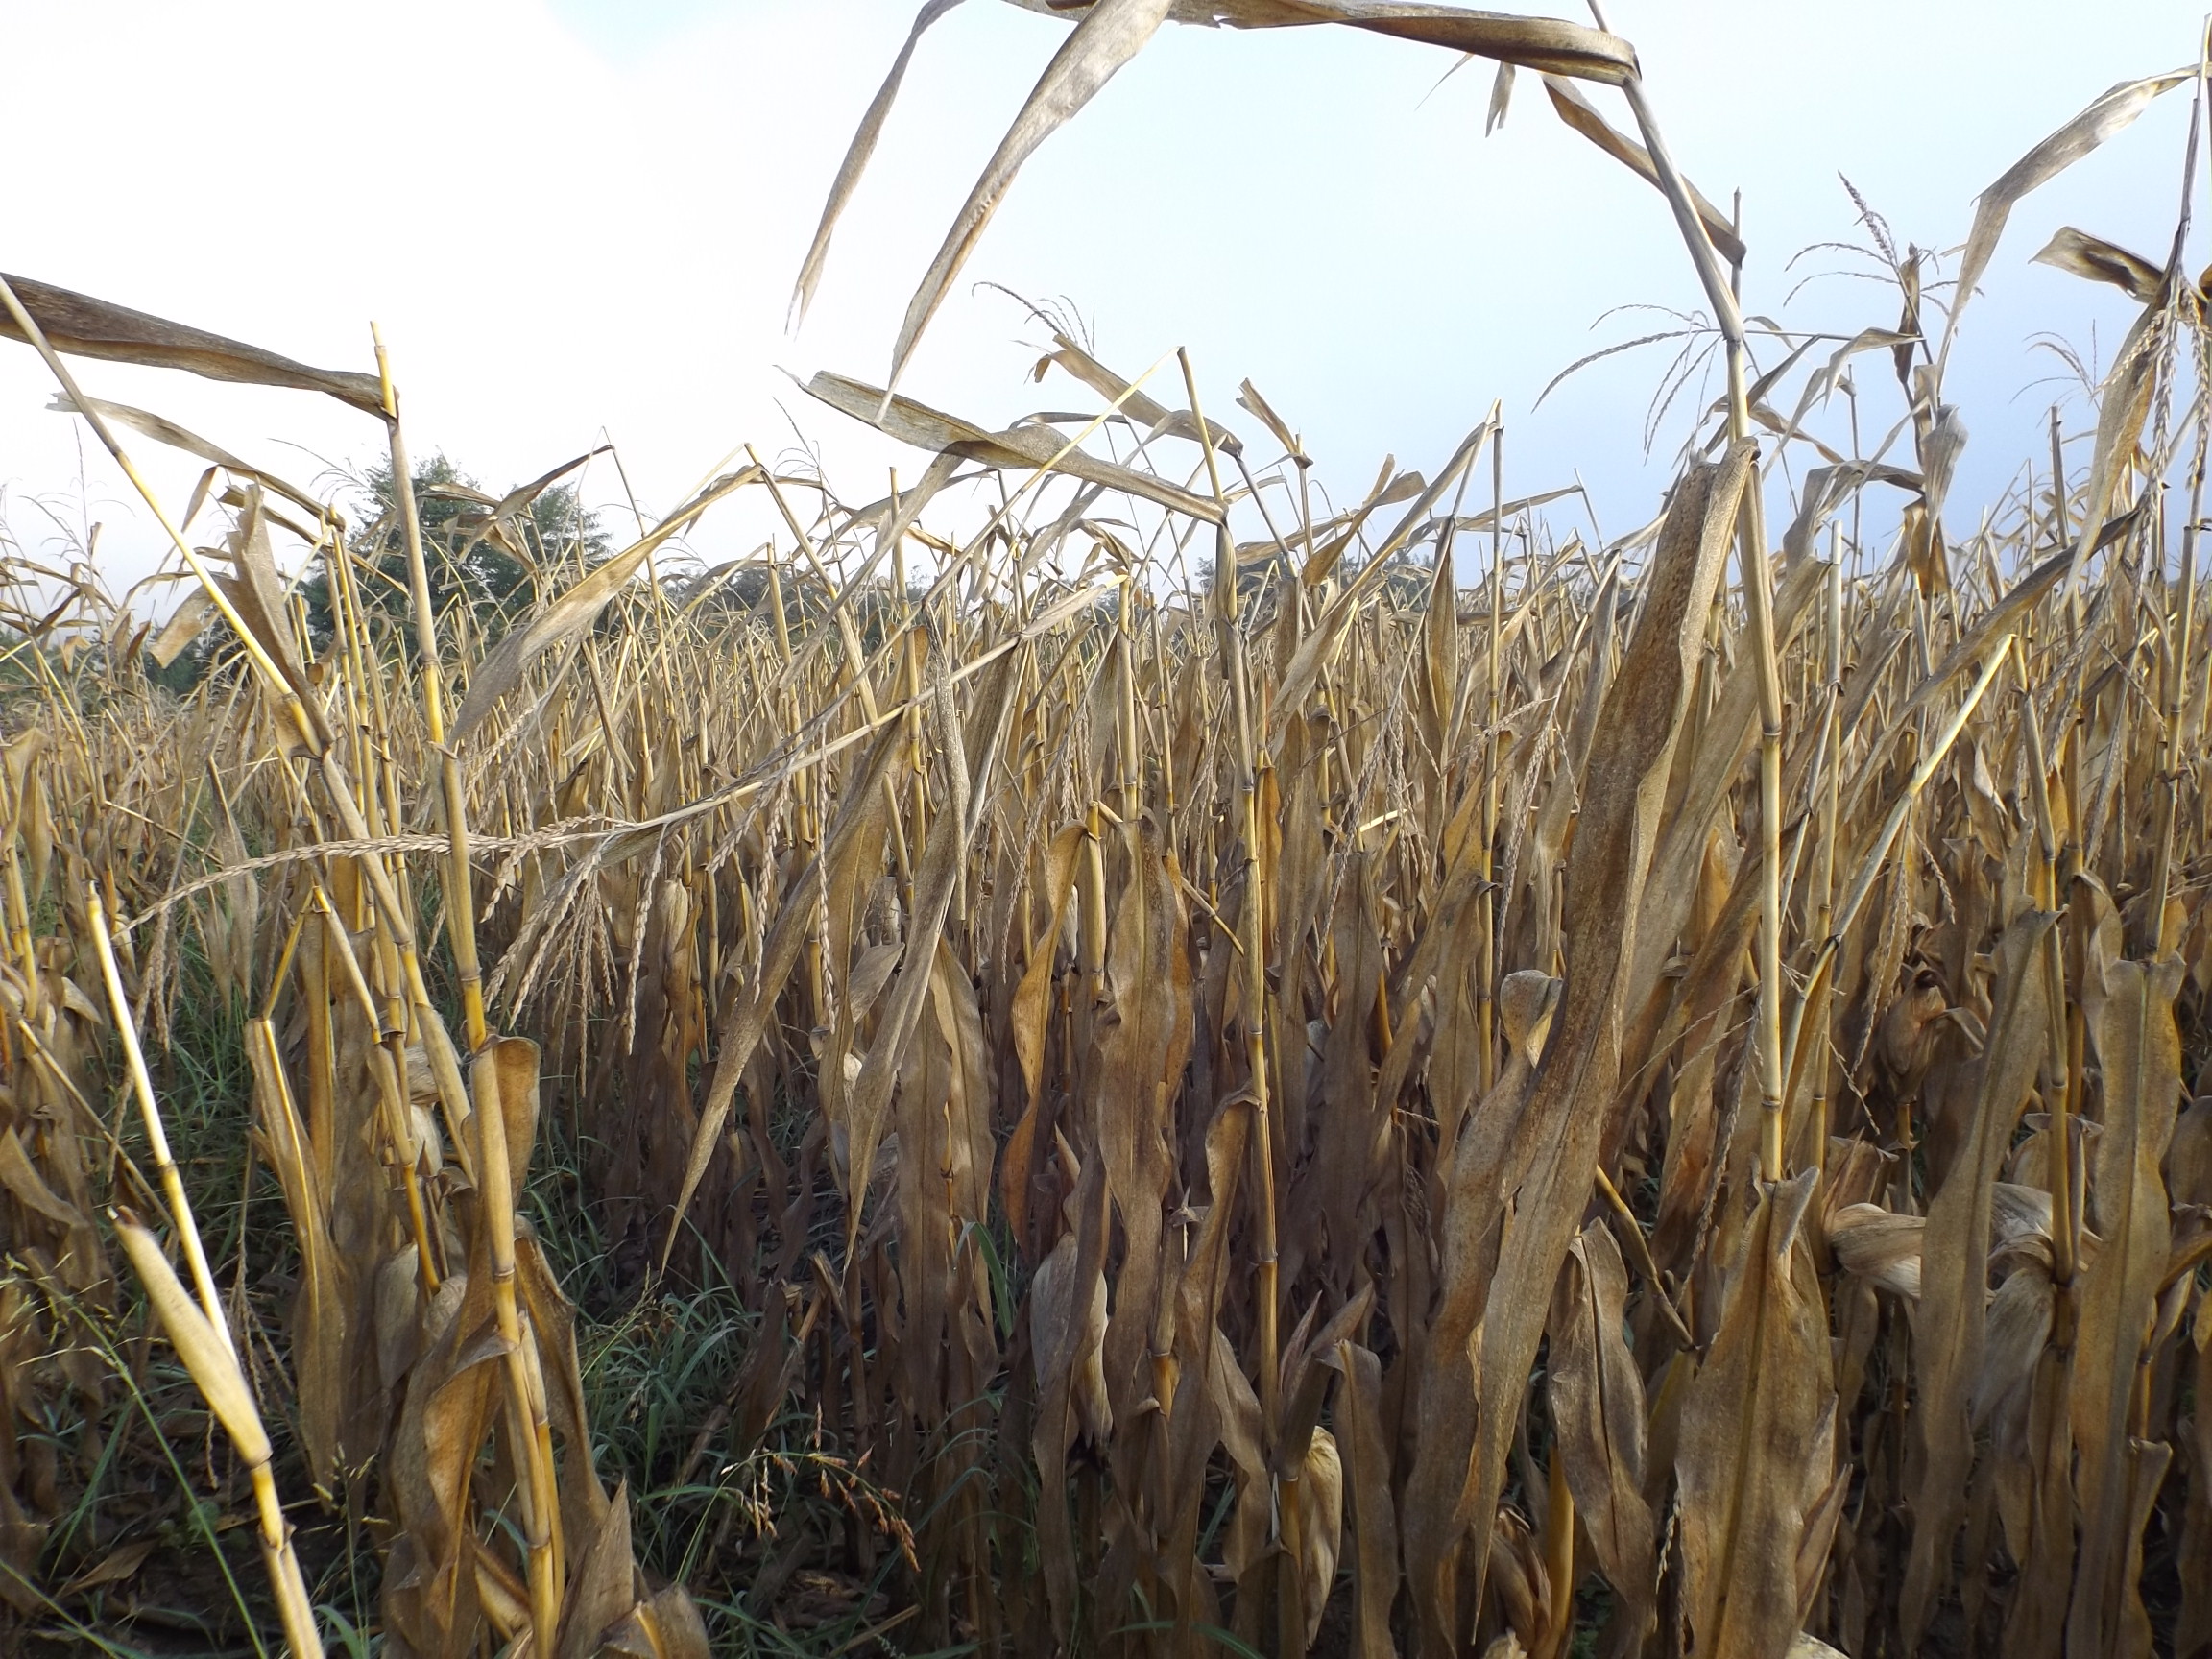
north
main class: Cropland
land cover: Maize
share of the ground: > 75 %
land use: Agriculture (excluding fallow land and kitchen gardens)
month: September
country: BG
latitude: 44.0227
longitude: 26.5420
